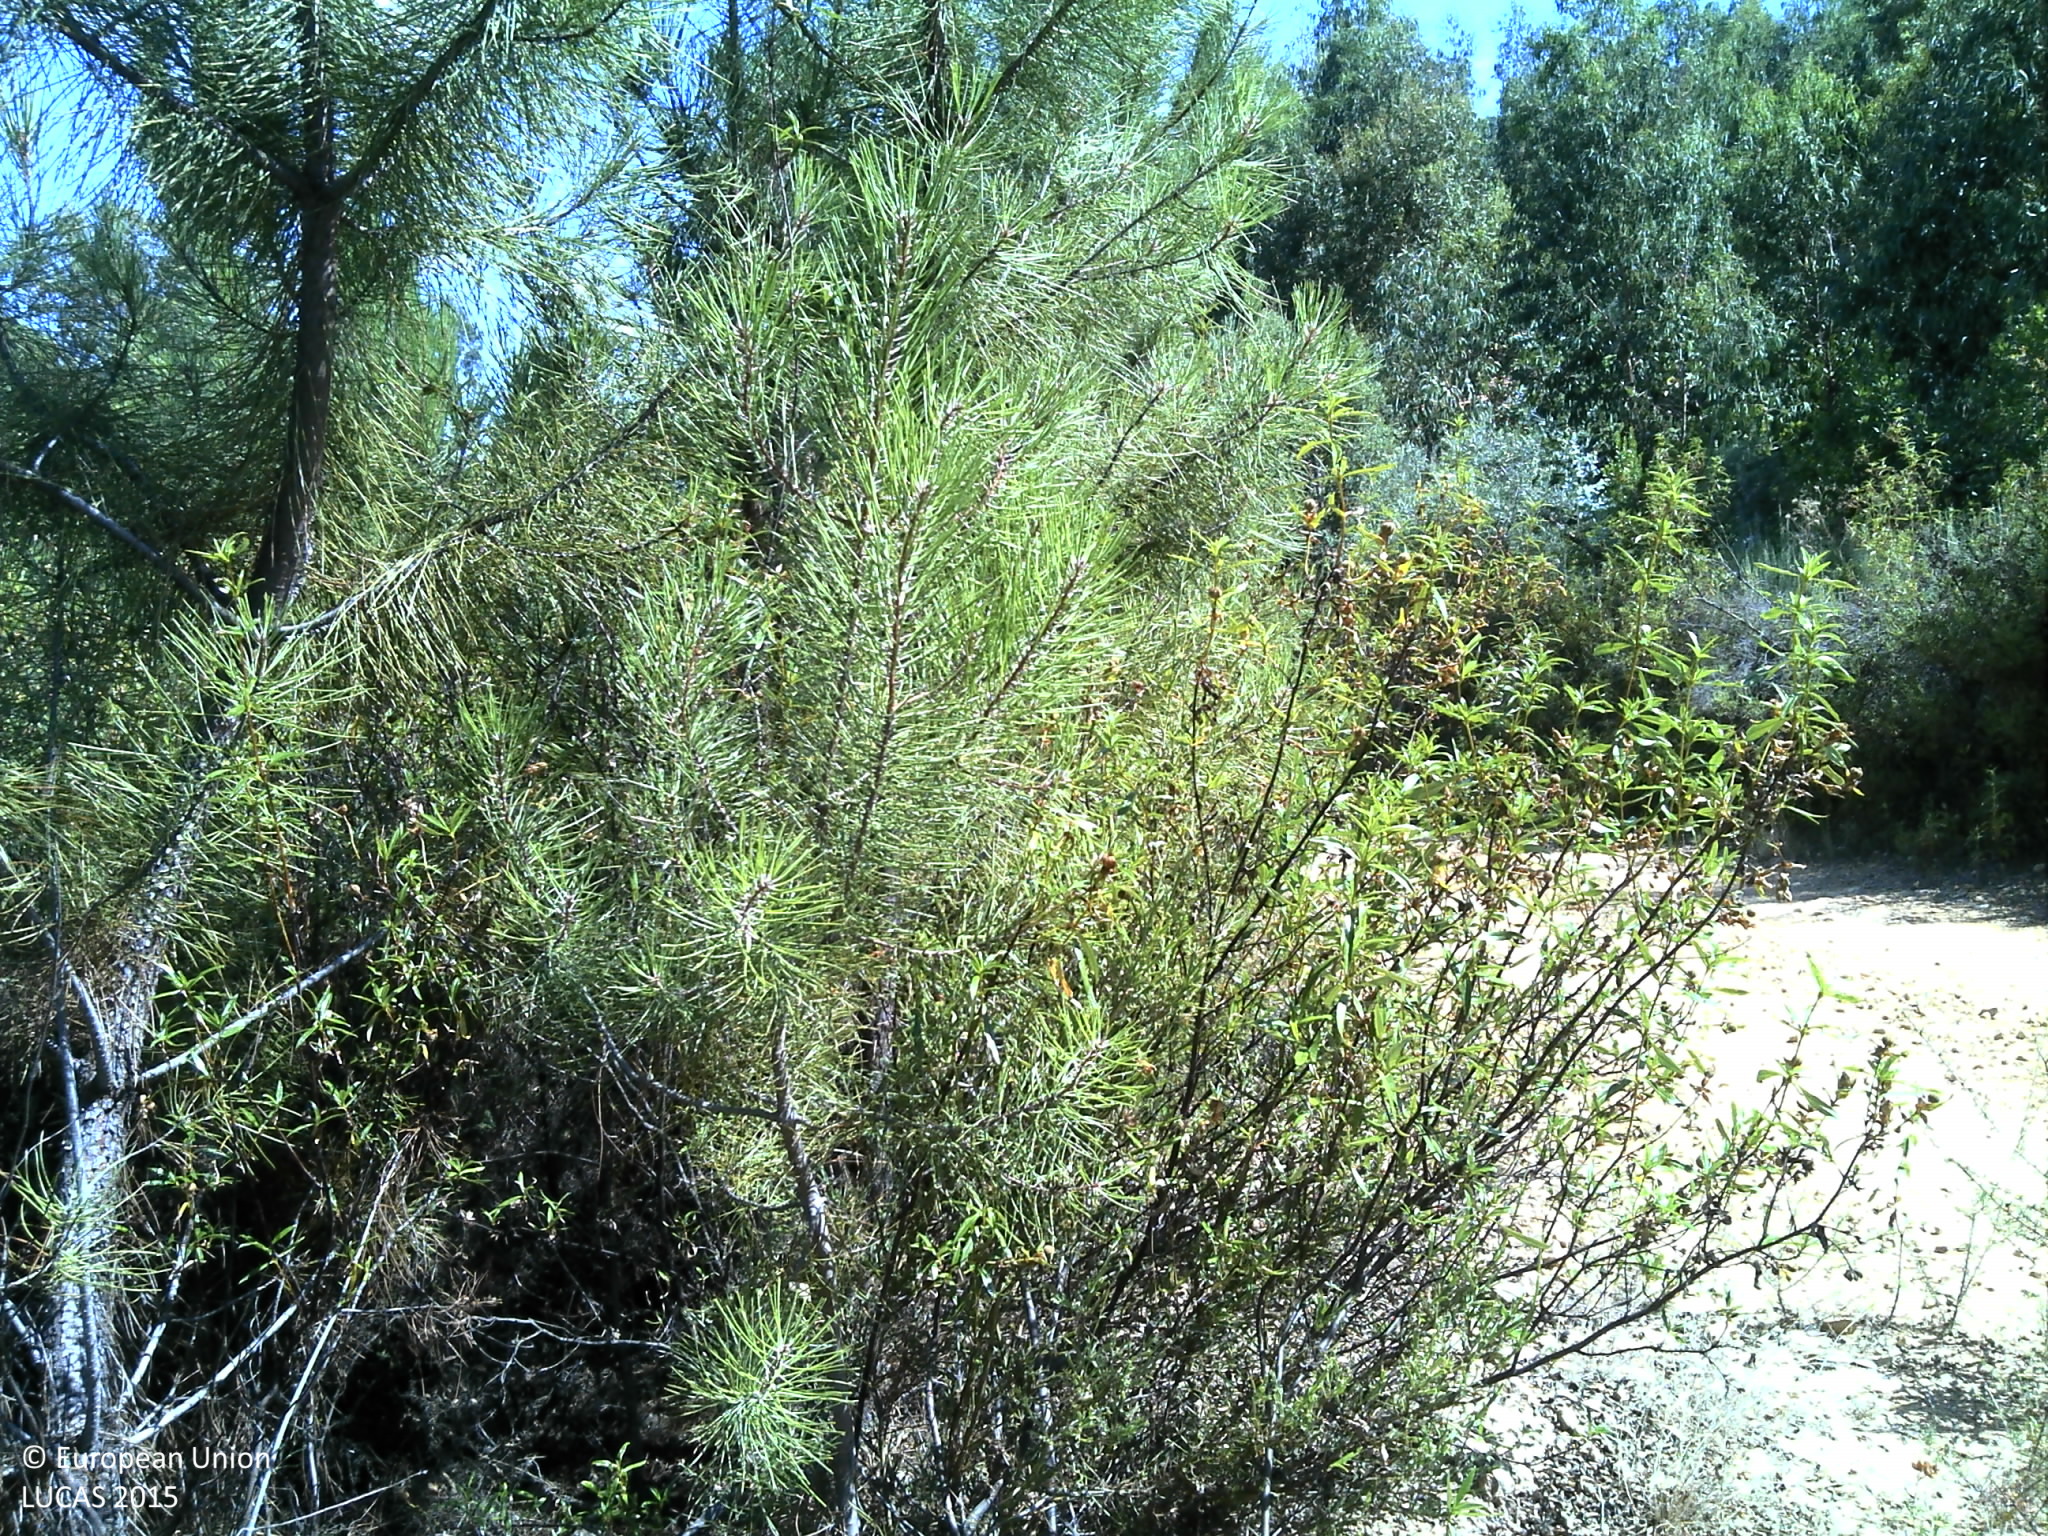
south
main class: Woodland
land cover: Pine dominated mixed woodland
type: coniferous forest of the mediterranean region
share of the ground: 25 - 50 %
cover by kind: shrubs 60 %, coniferous forest trees 15 %, broadleaved forest trees 10 %, unconsolidated bare surface 10 %, consolidated bare surface 5 %
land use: Forestry
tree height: > 5 m
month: July
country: PT
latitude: 39.8066
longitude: -7.8022
